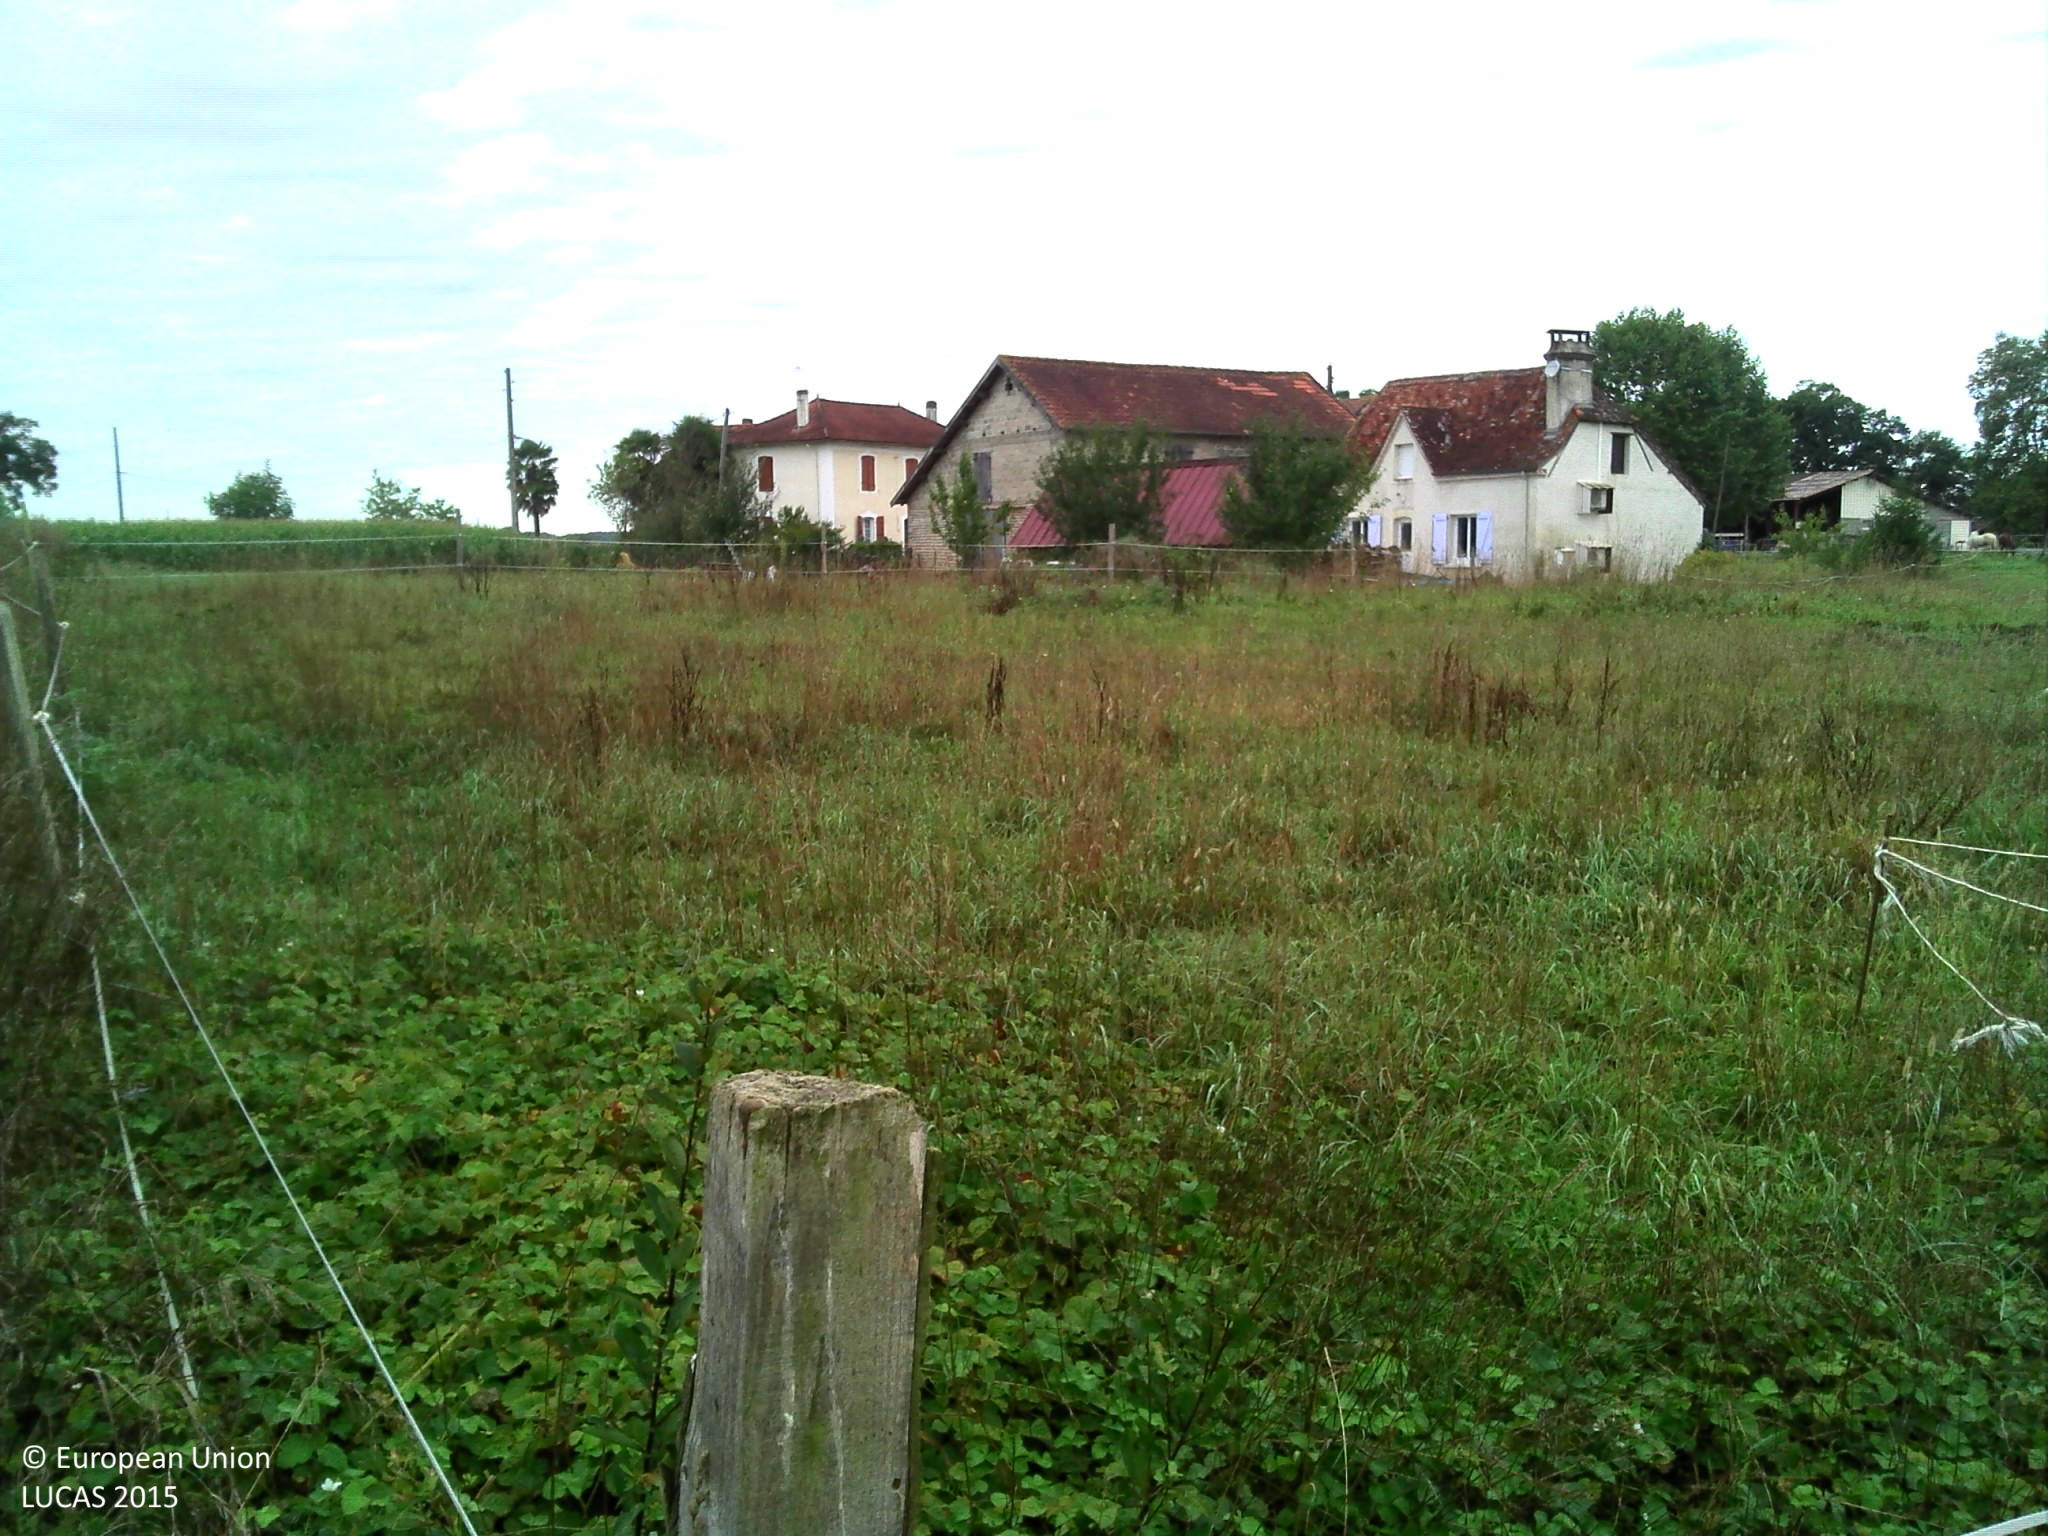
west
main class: Cropland
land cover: Maize
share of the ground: > 75 %
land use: Agriculture (excluding fallow land and kitchen gardens)
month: September
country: FR
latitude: 43.4706
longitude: -0.5040
